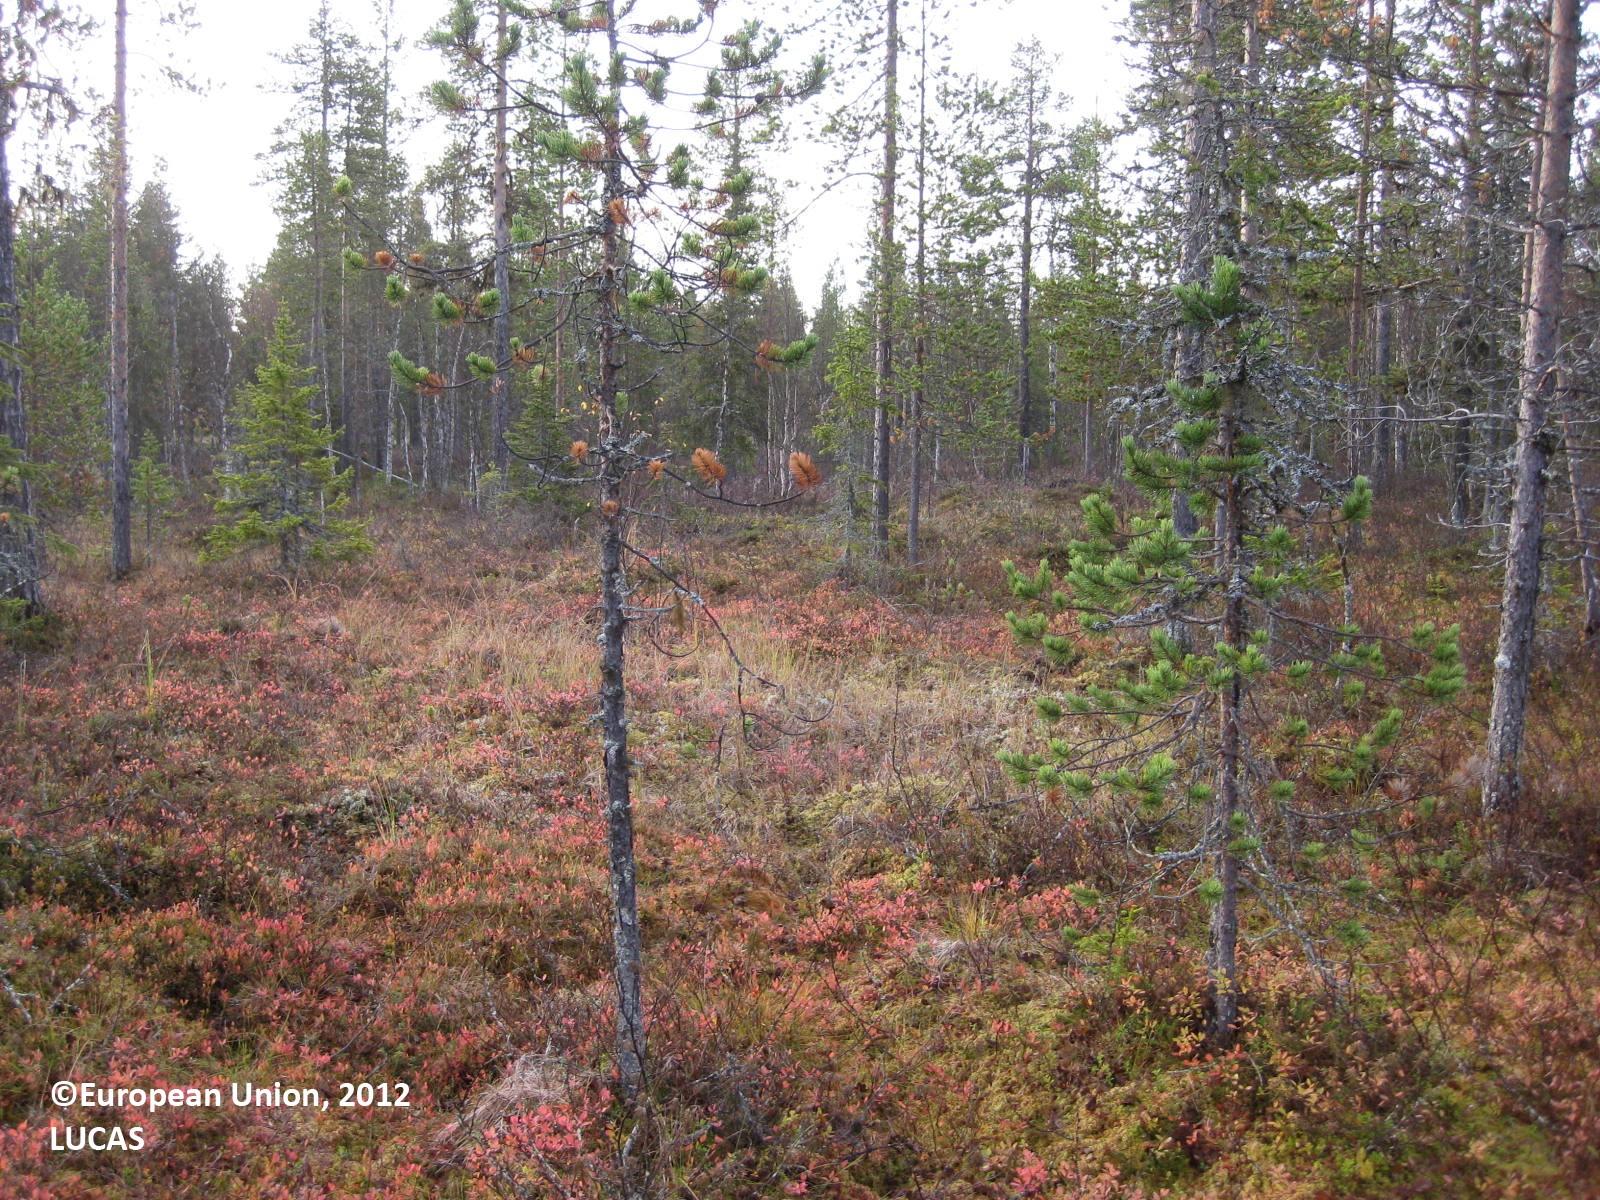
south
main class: Woodland
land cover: Pine dominated coniferous woodland
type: boreal forest
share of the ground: 50 - 75 %
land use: Forestry
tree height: > 5 m
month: September
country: FI
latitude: 68.1276
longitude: 24.2328
